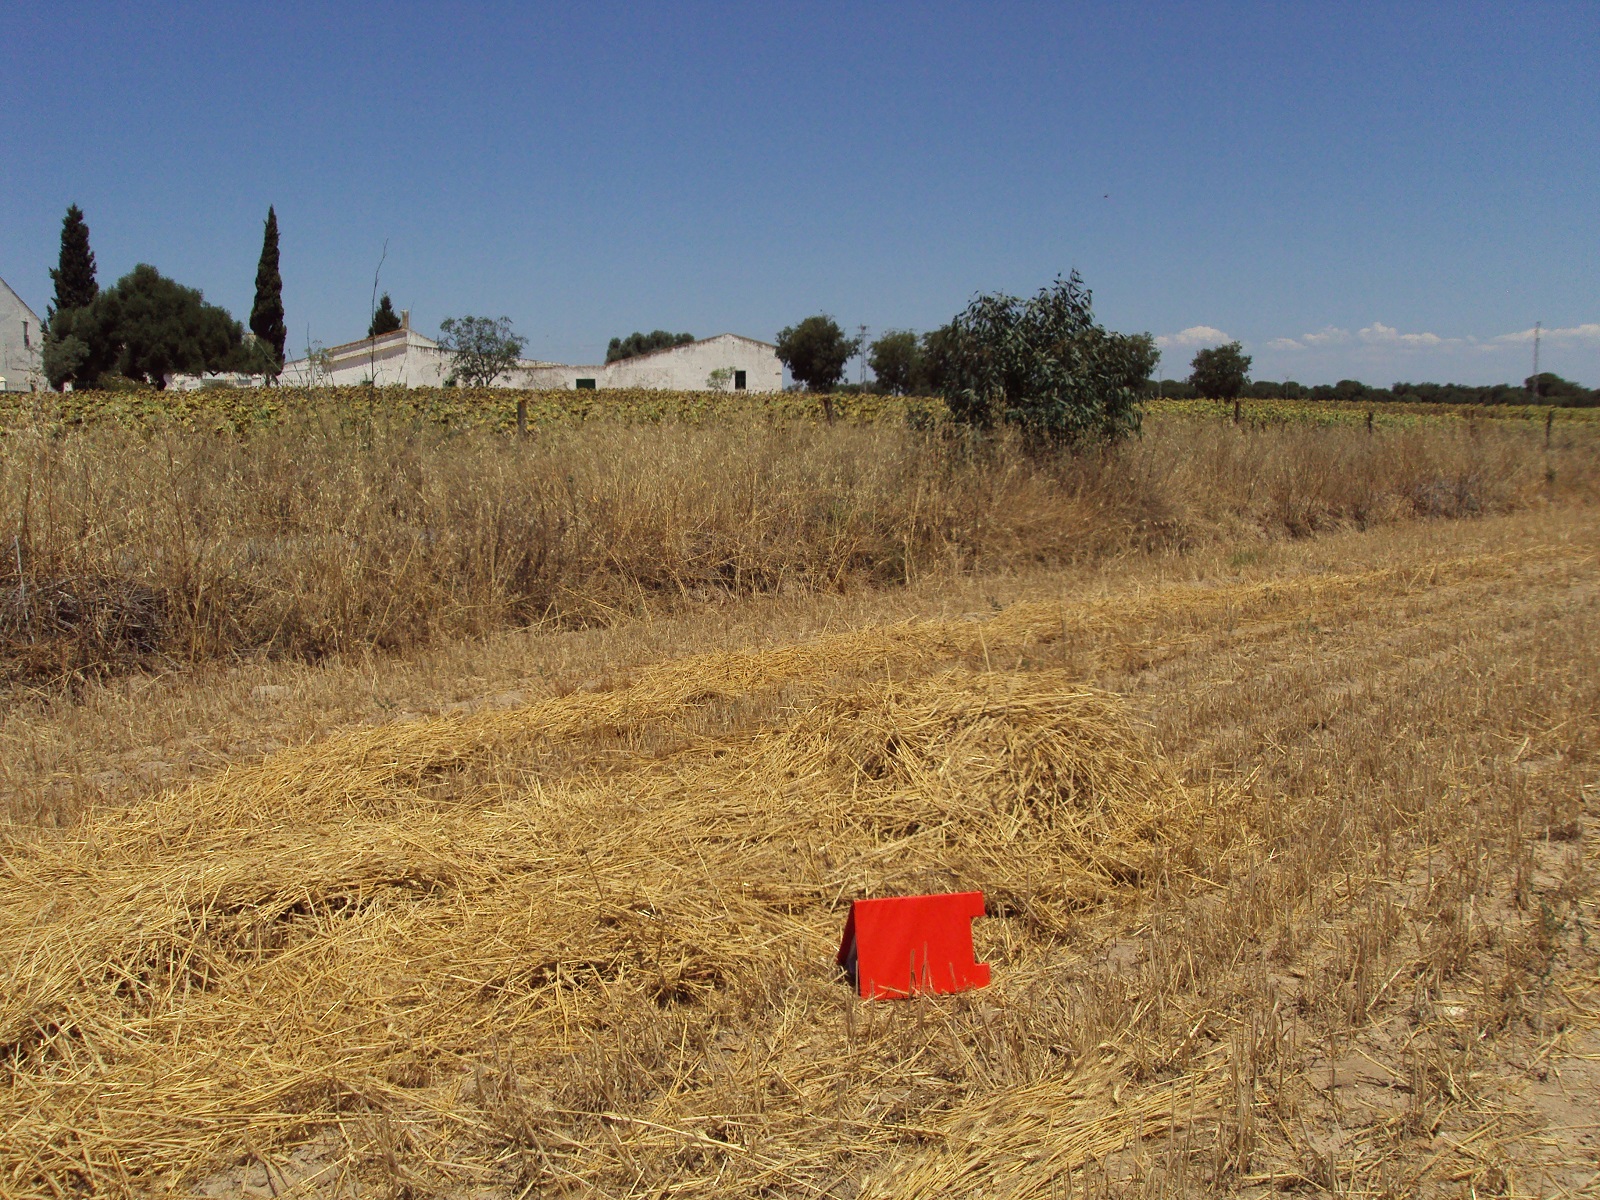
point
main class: Cropland
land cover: Durum wheat
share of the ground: > 75 %
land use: Agriculture (excluding fallow land and kitchen gardens)
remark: Harvested field
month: June
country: ES
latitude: 37.3727
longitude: -6.8761
